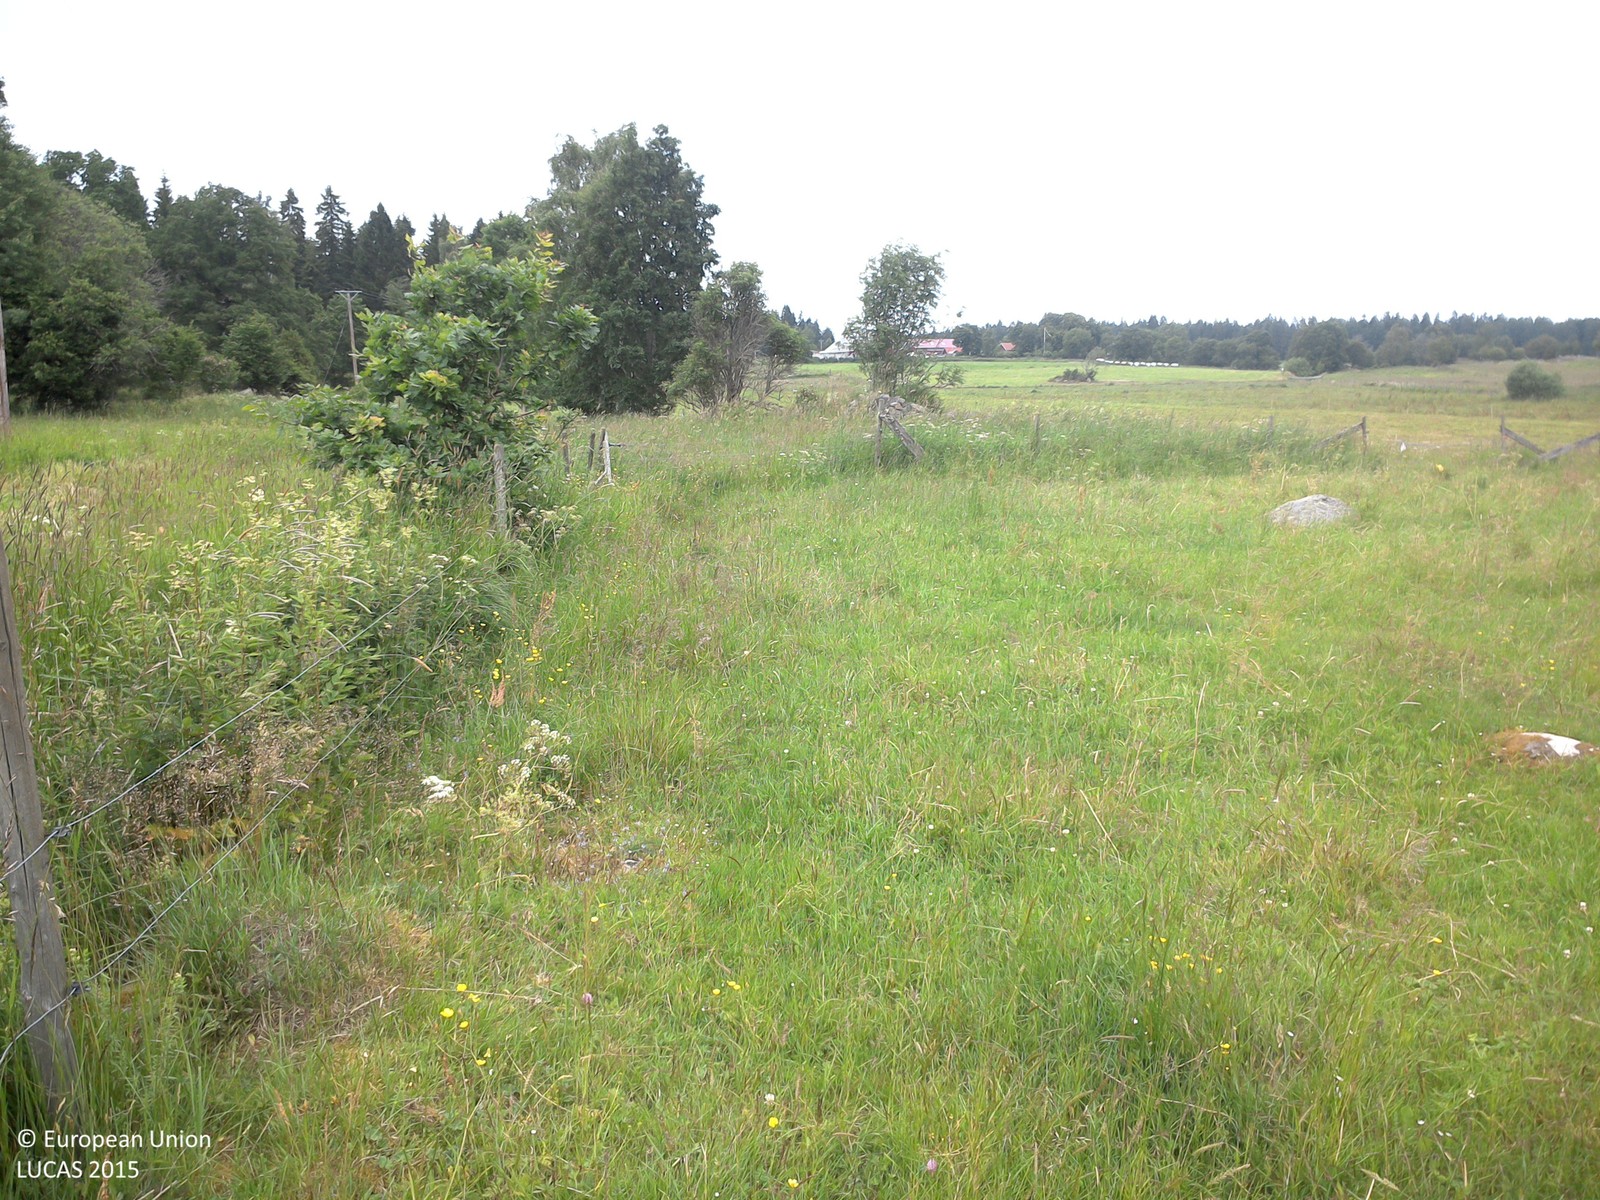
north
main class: Grassland
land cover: Grassland without tree/shrub cover
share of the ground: > 75 %
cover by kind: herbaceous plants 100 %
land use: Agriculture (excluding fallow land and kitchen gardens)
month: June
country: SE
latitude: 58.3065
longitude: 15.4726
